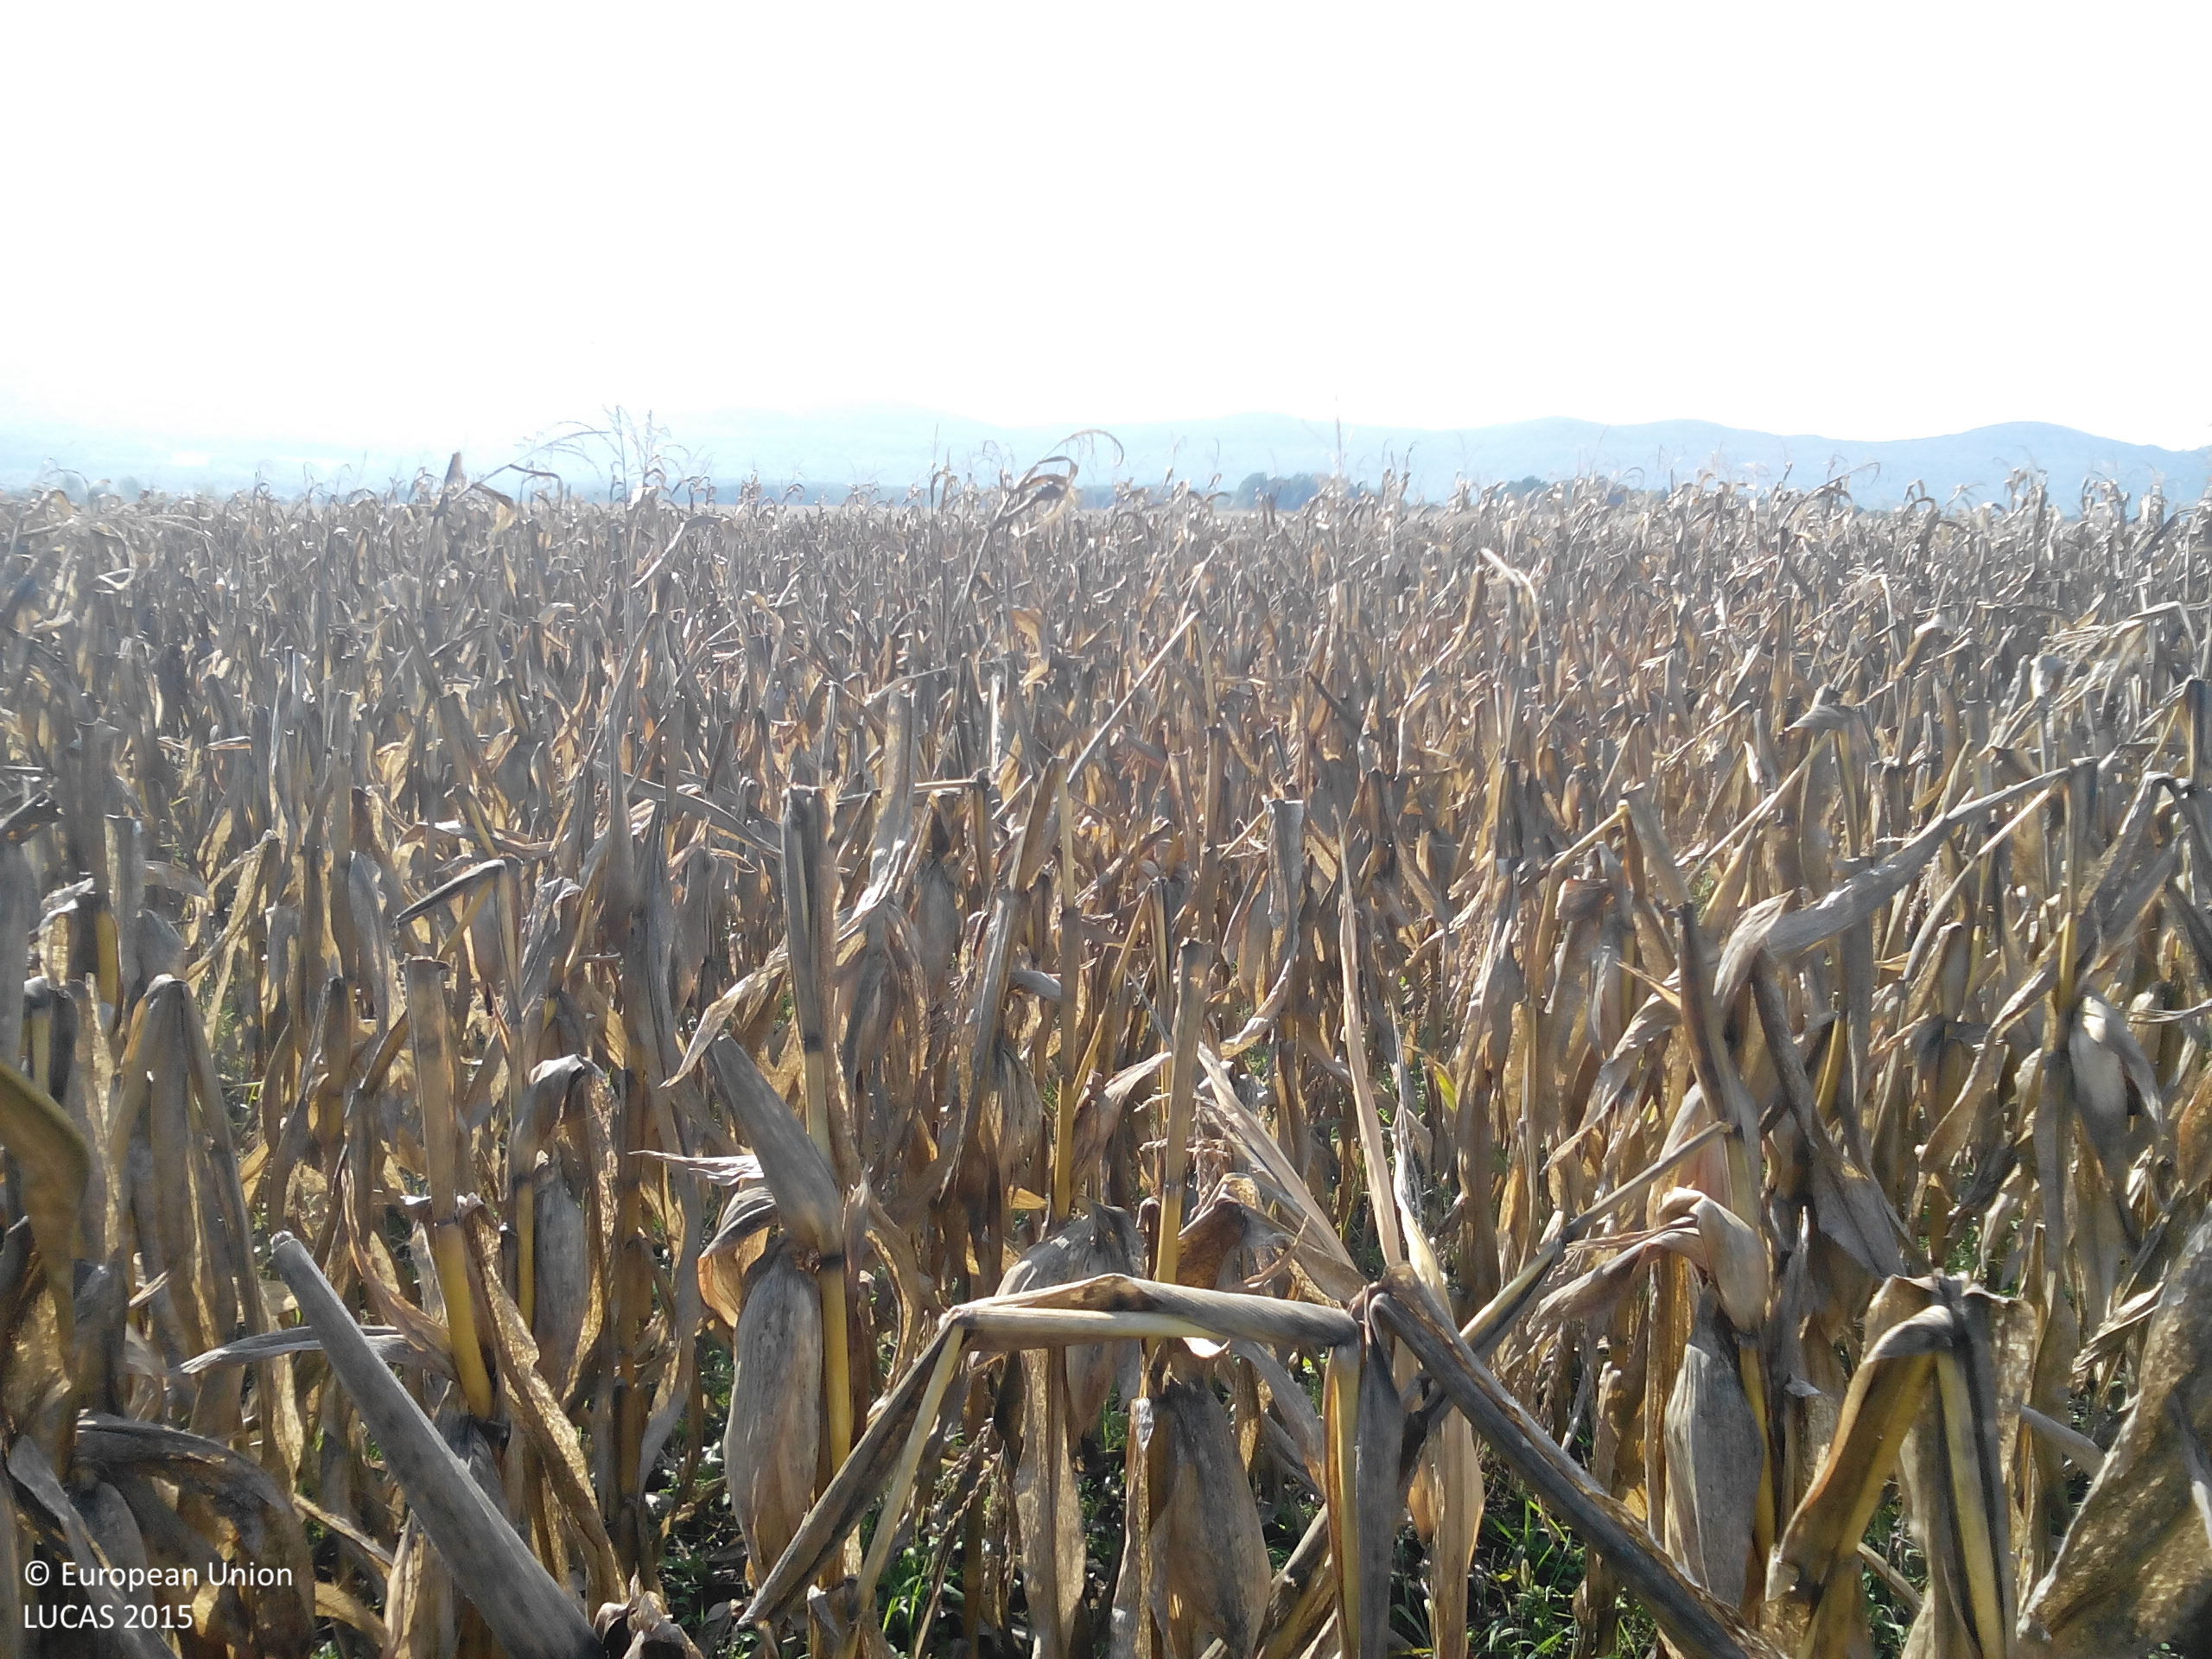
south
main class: Cropland
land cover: Maize
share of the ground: > 75 %
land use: Agriculture (excluding fallow land and kitchen gardens)
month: October
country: BG
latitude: 43.2679
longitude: 23.7341
